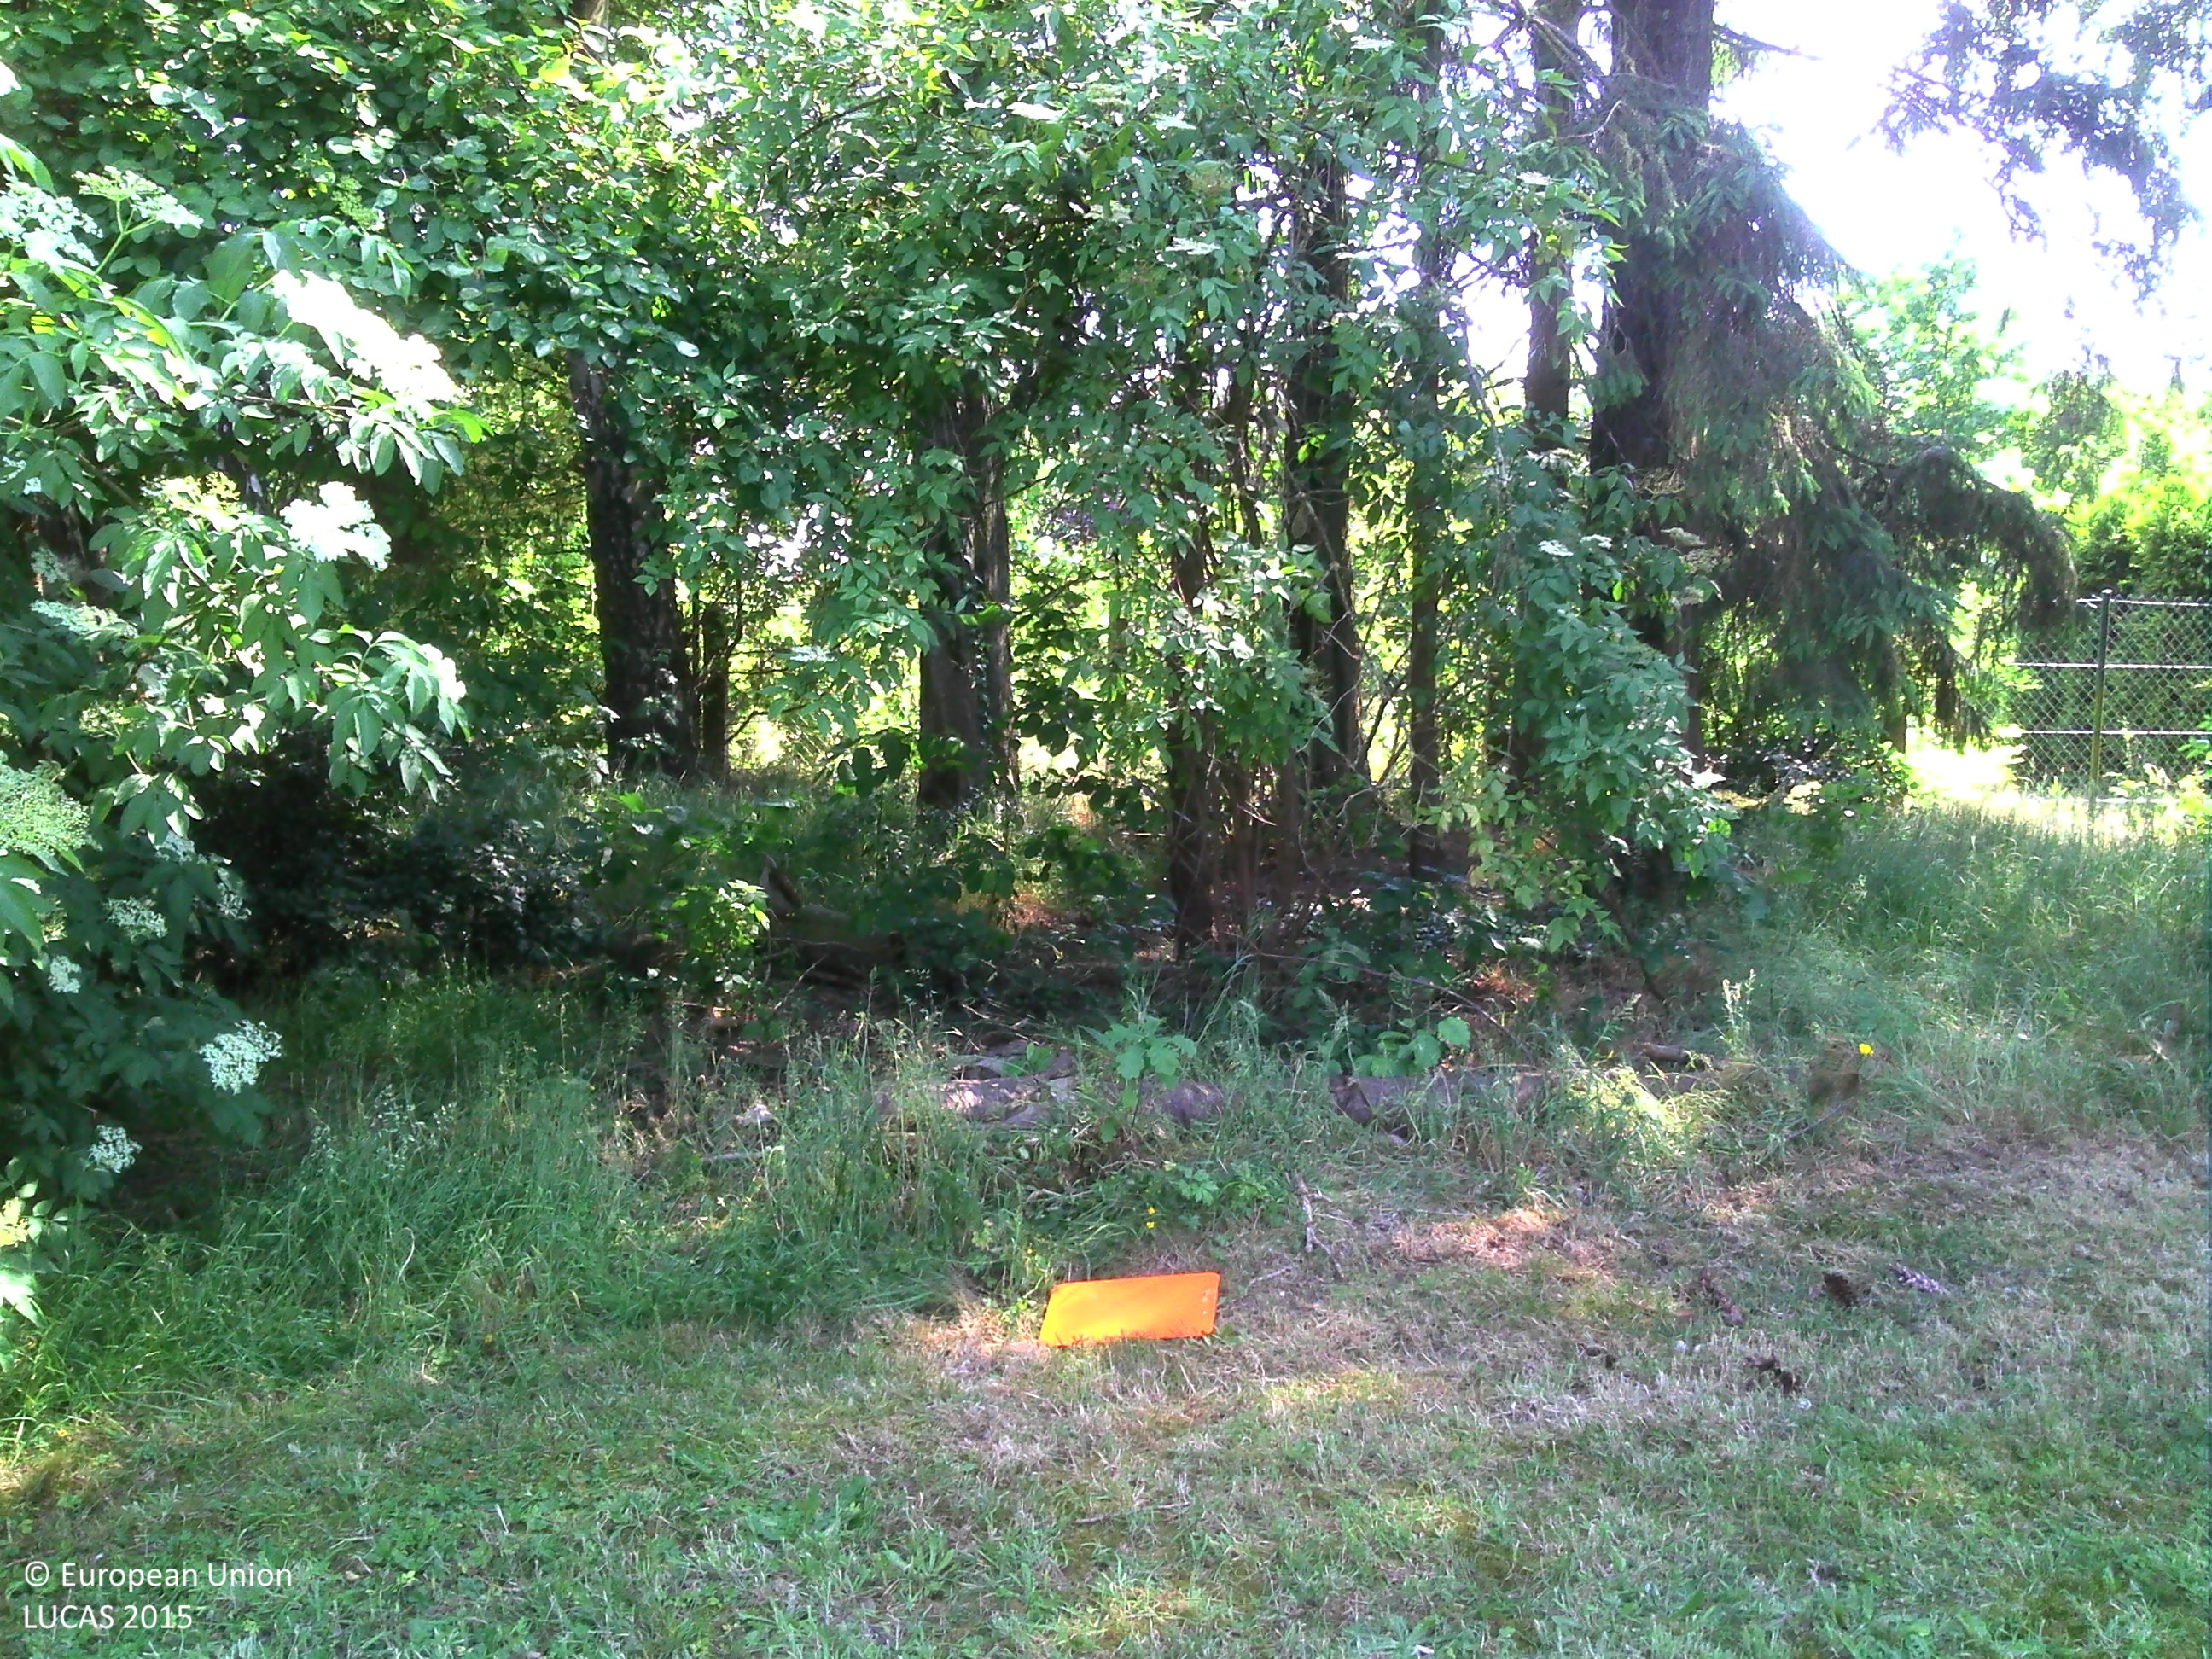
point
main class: Woodland
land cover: Other mixed woodland
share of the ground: > 75 %
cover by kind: broadleaved forest trees 70 %, coniferous forest trees 25 %, herbaceous plants 5 %
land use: Residential
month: June
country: BE
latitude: 50.9478
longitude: 5.2008
